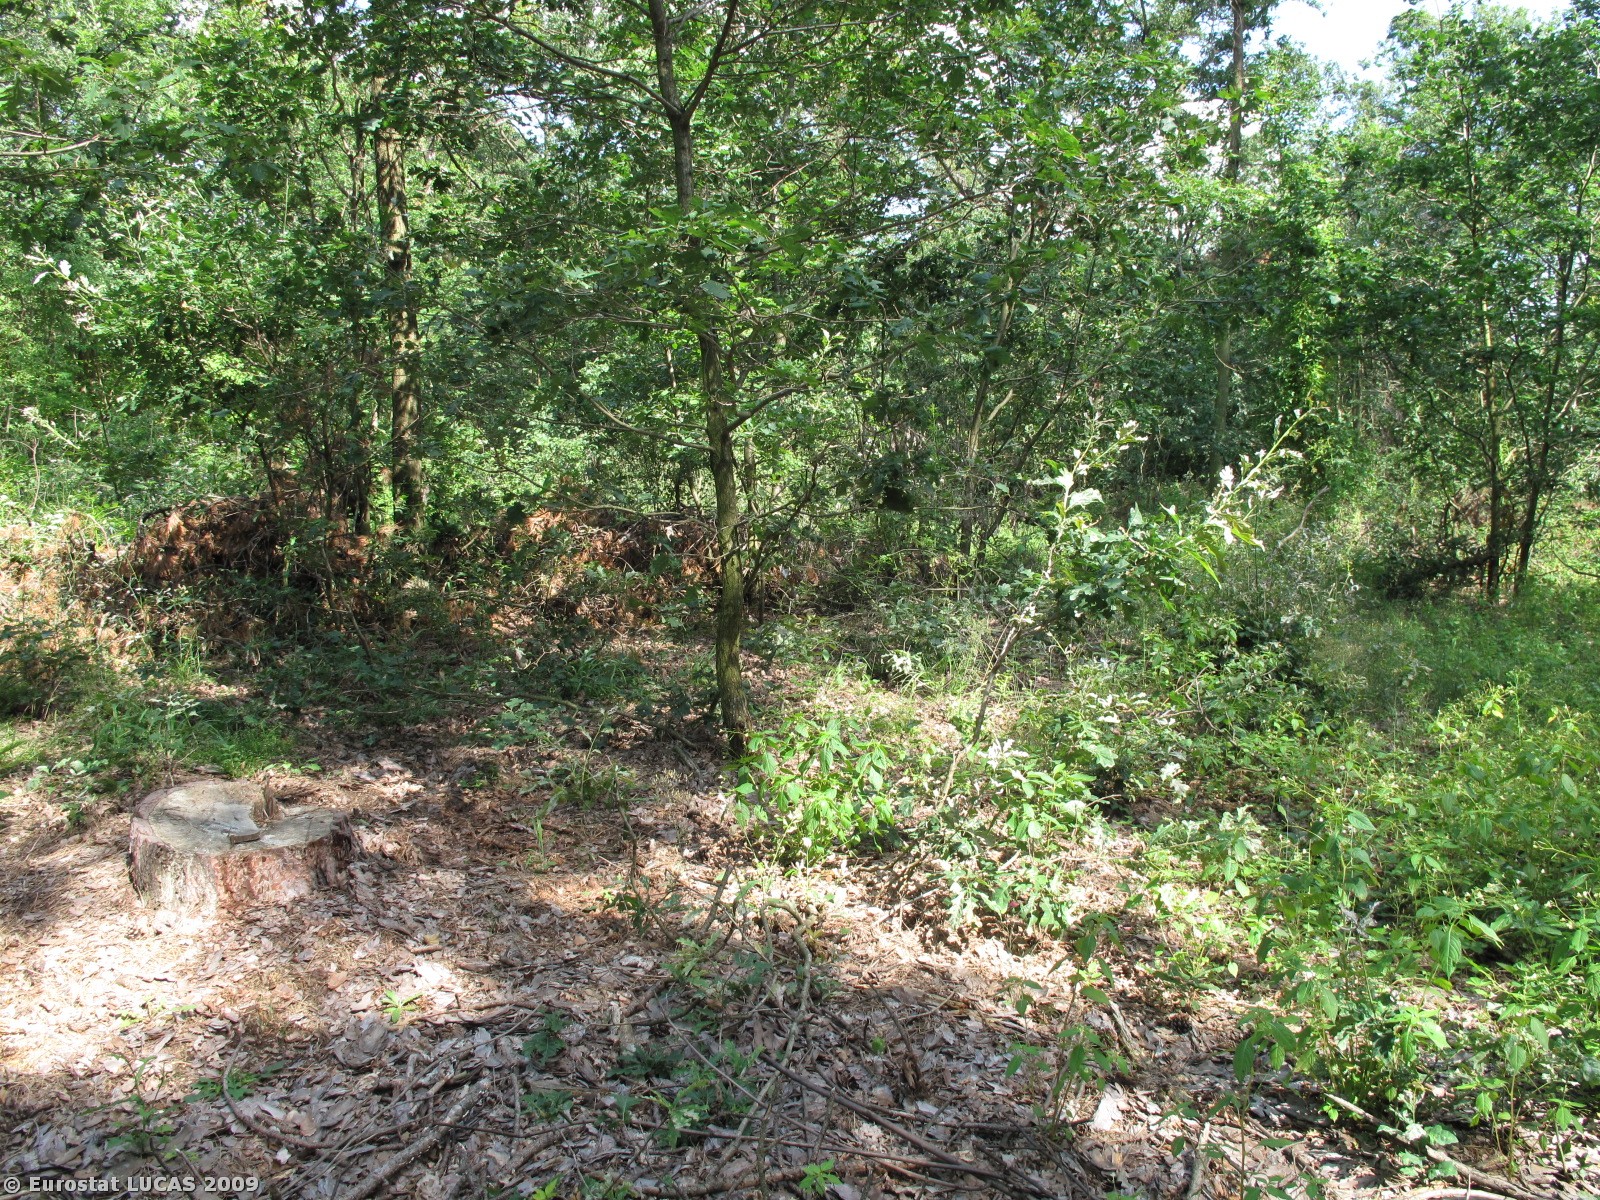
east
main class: Woodland
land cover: Broadleaved woodland
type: acidophilous oak and oak-birch forest
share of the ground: 10 - 25 %
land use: Forestry
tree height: > 5 m
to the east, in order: Broadleaved woodland; Tracks; Broadleaved woodland
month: May
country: AT
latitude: 48.5828
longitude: 16.0096
